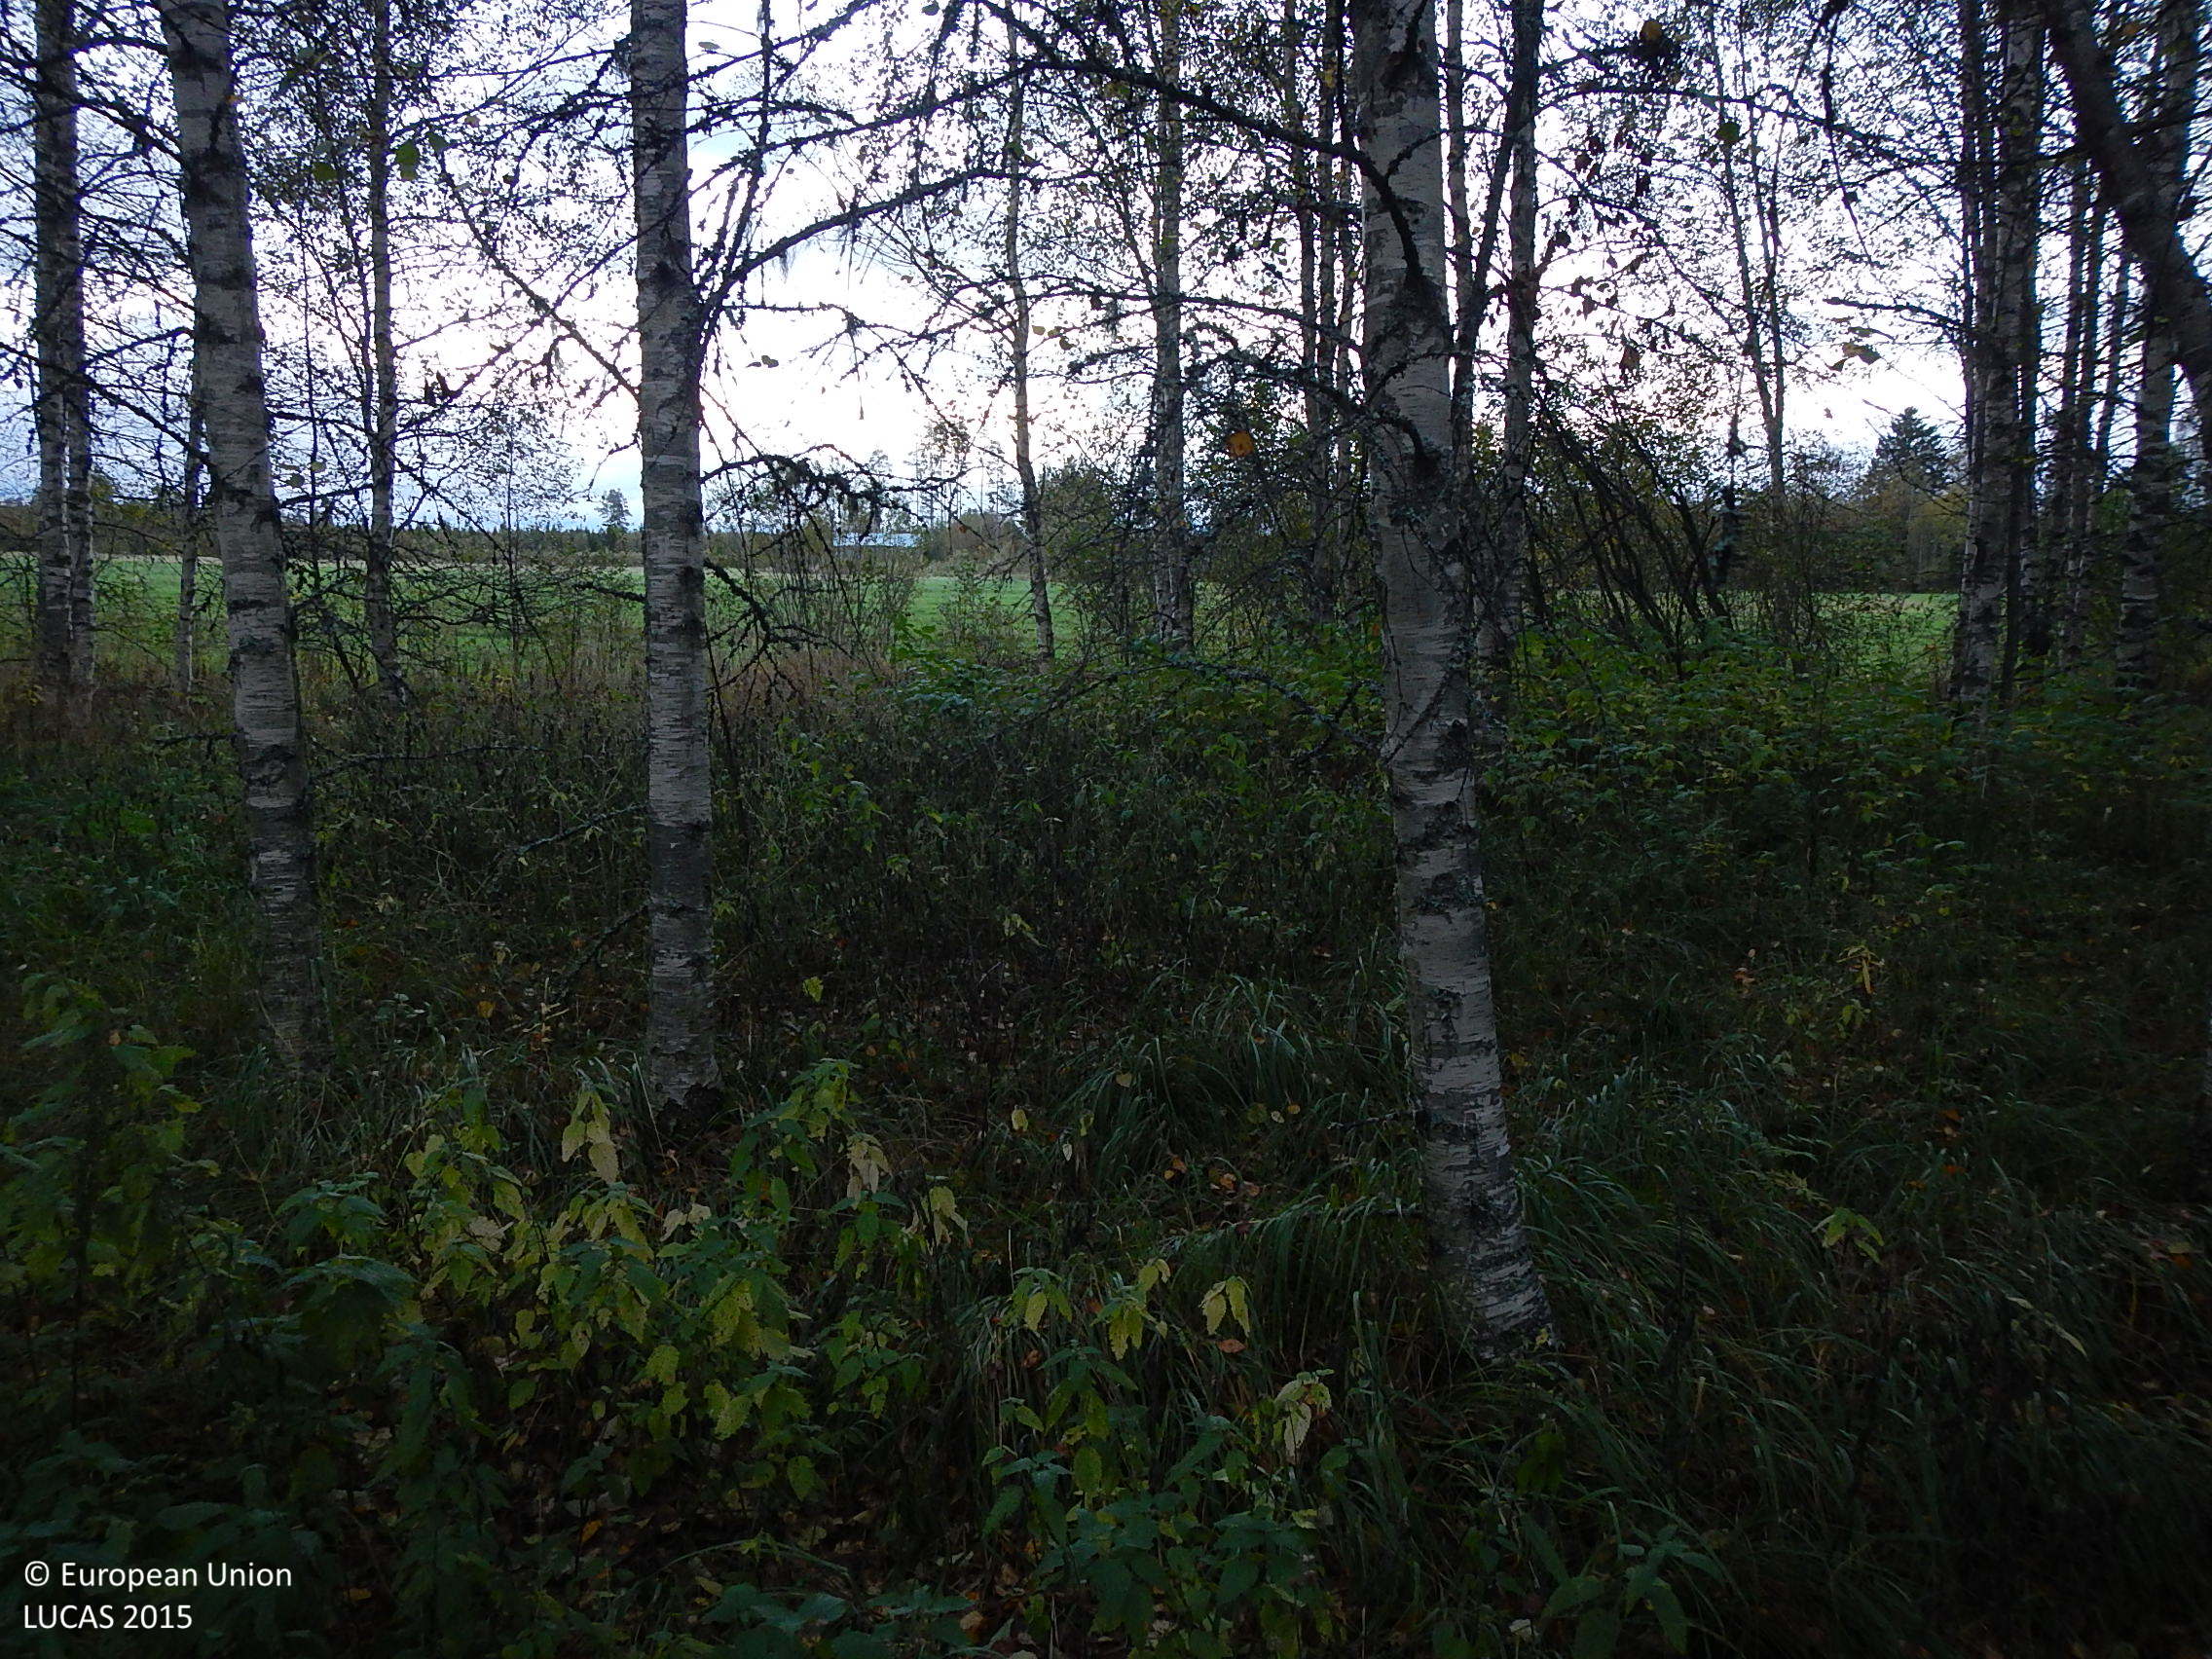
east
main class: Woodland
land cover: Broadleaved woodland
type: non-riverine alder, birch or aspen forest
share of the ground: 50 - 75 %
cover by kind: broadleaved forest trees 70 %, herbaceous plants 30 %
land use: Forestry
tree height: > 5 m
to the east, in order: Broadleaved woodland; Ditches and canals; Grass margins; Temporary grasslands; Ditches and canals; Broadleaved woodland; Ditches and canals; Tracks; Grass margins; Ditches and canals; Broadleaved woodland
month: September
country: FI
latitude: 61.8700
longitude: 22.7072
